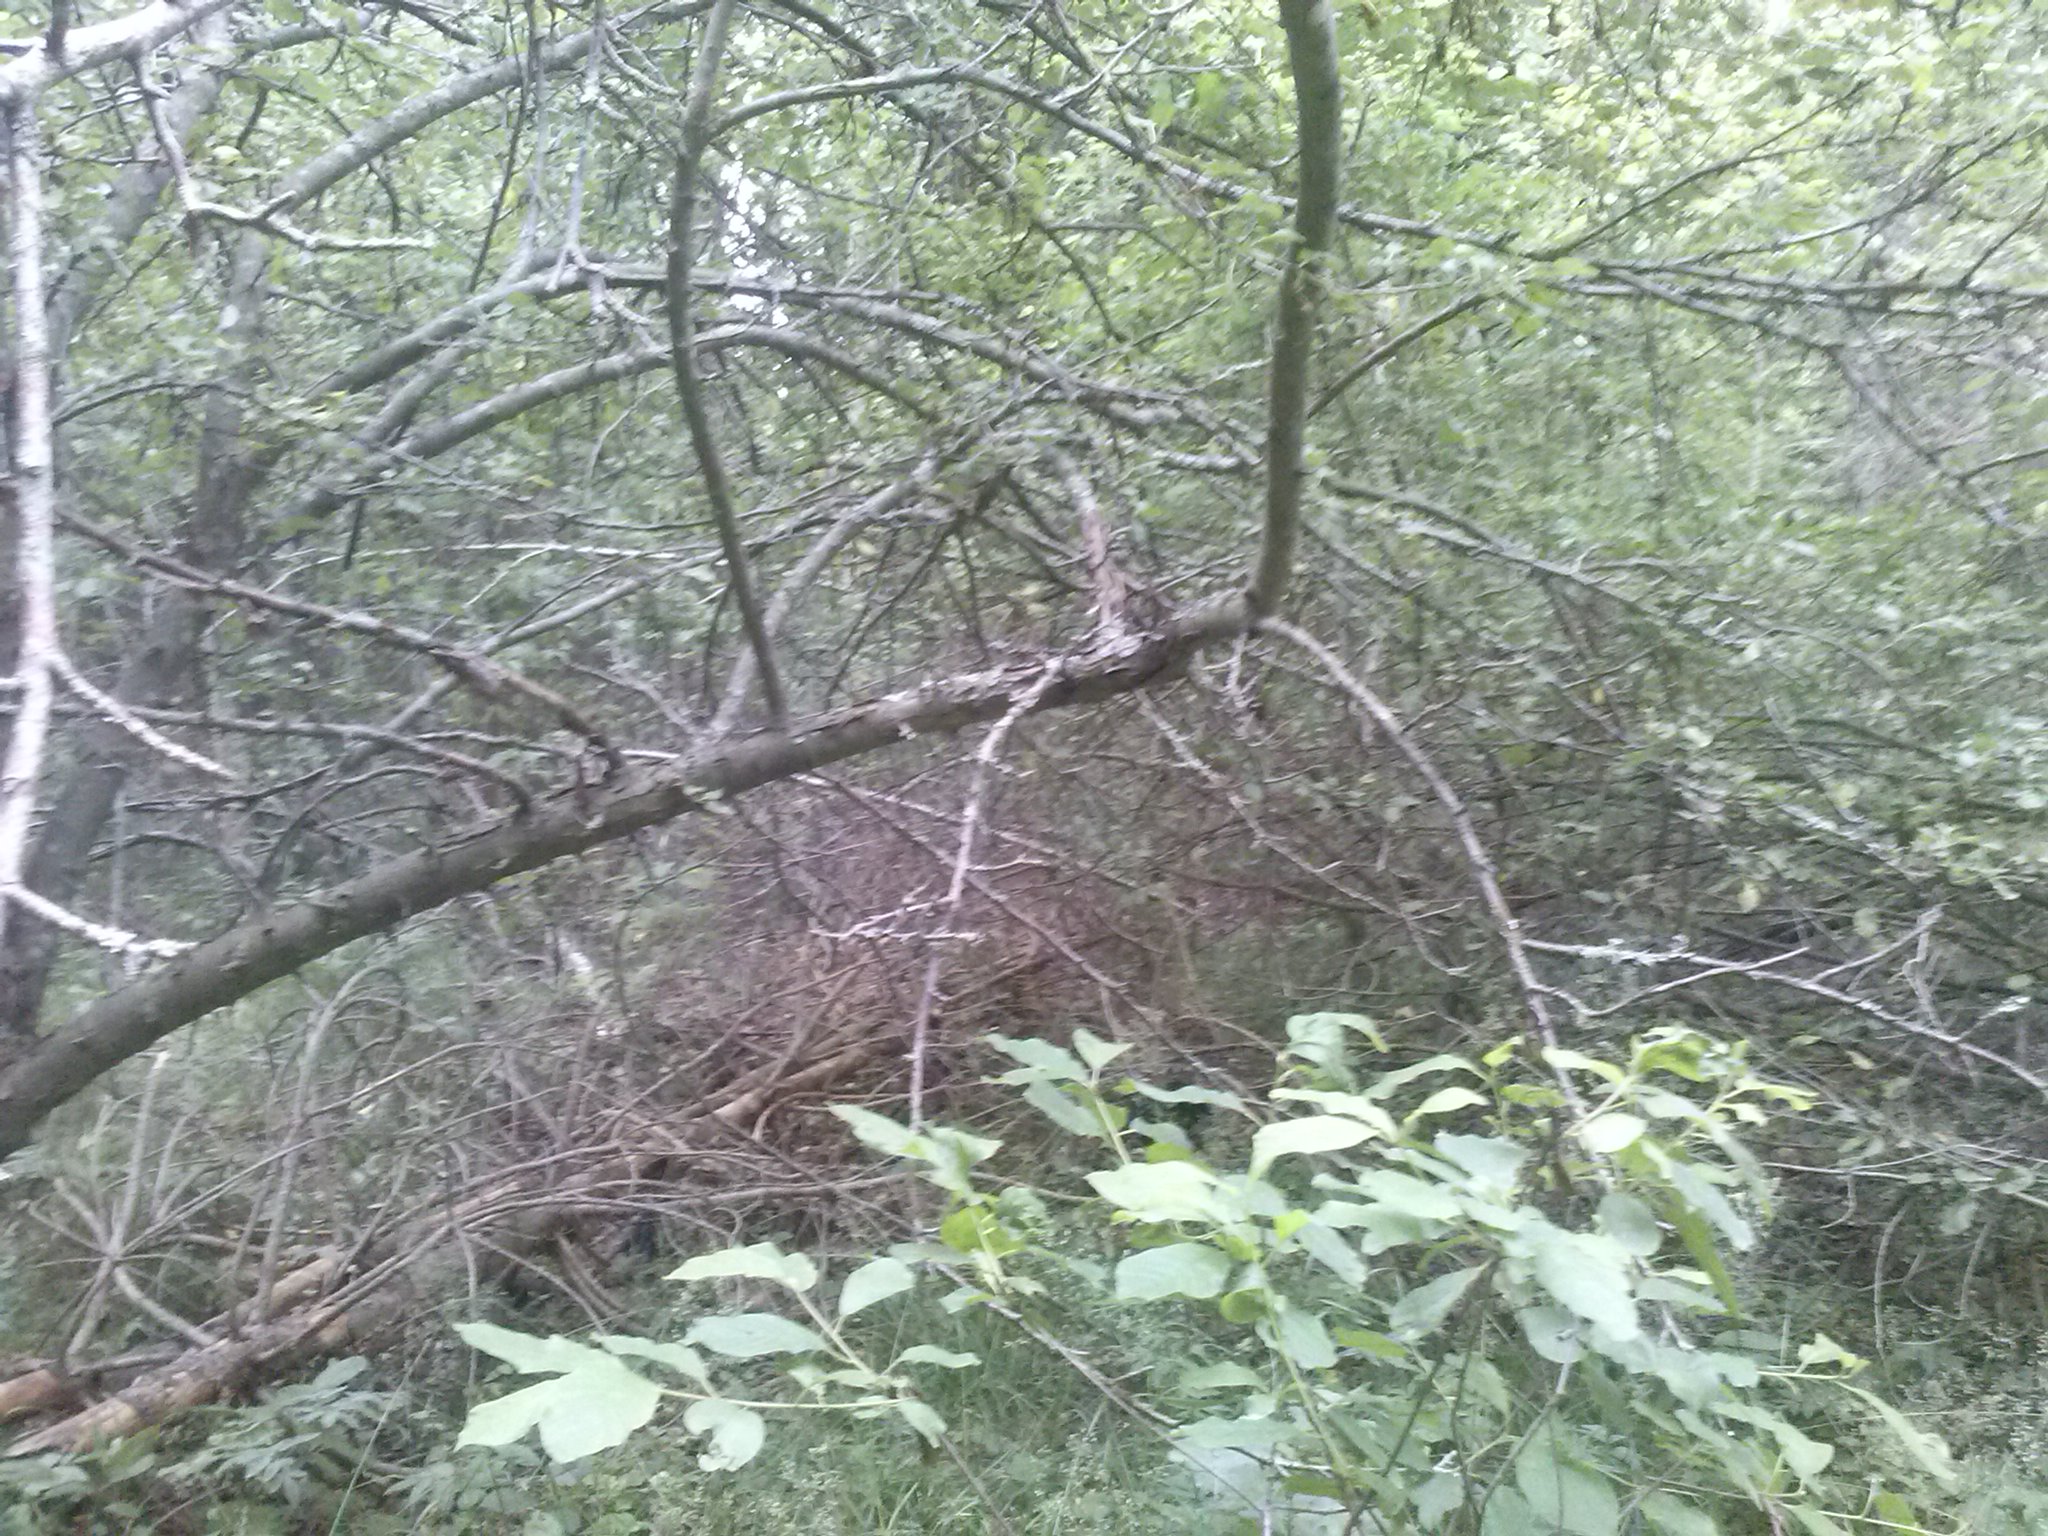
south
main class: Woodland
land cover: Broadleaved woodland
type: non-riverine alder, birch or aspen forest
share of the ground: > 75 %
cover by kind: broadleaved forest trees 80 %, shrubs 10 %, coniferous forest trees 5 %, herbaceous plants 5 %
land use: Forestry
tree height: > 5 m
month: July
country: LV
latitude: 56.8304
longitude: 27.3982
